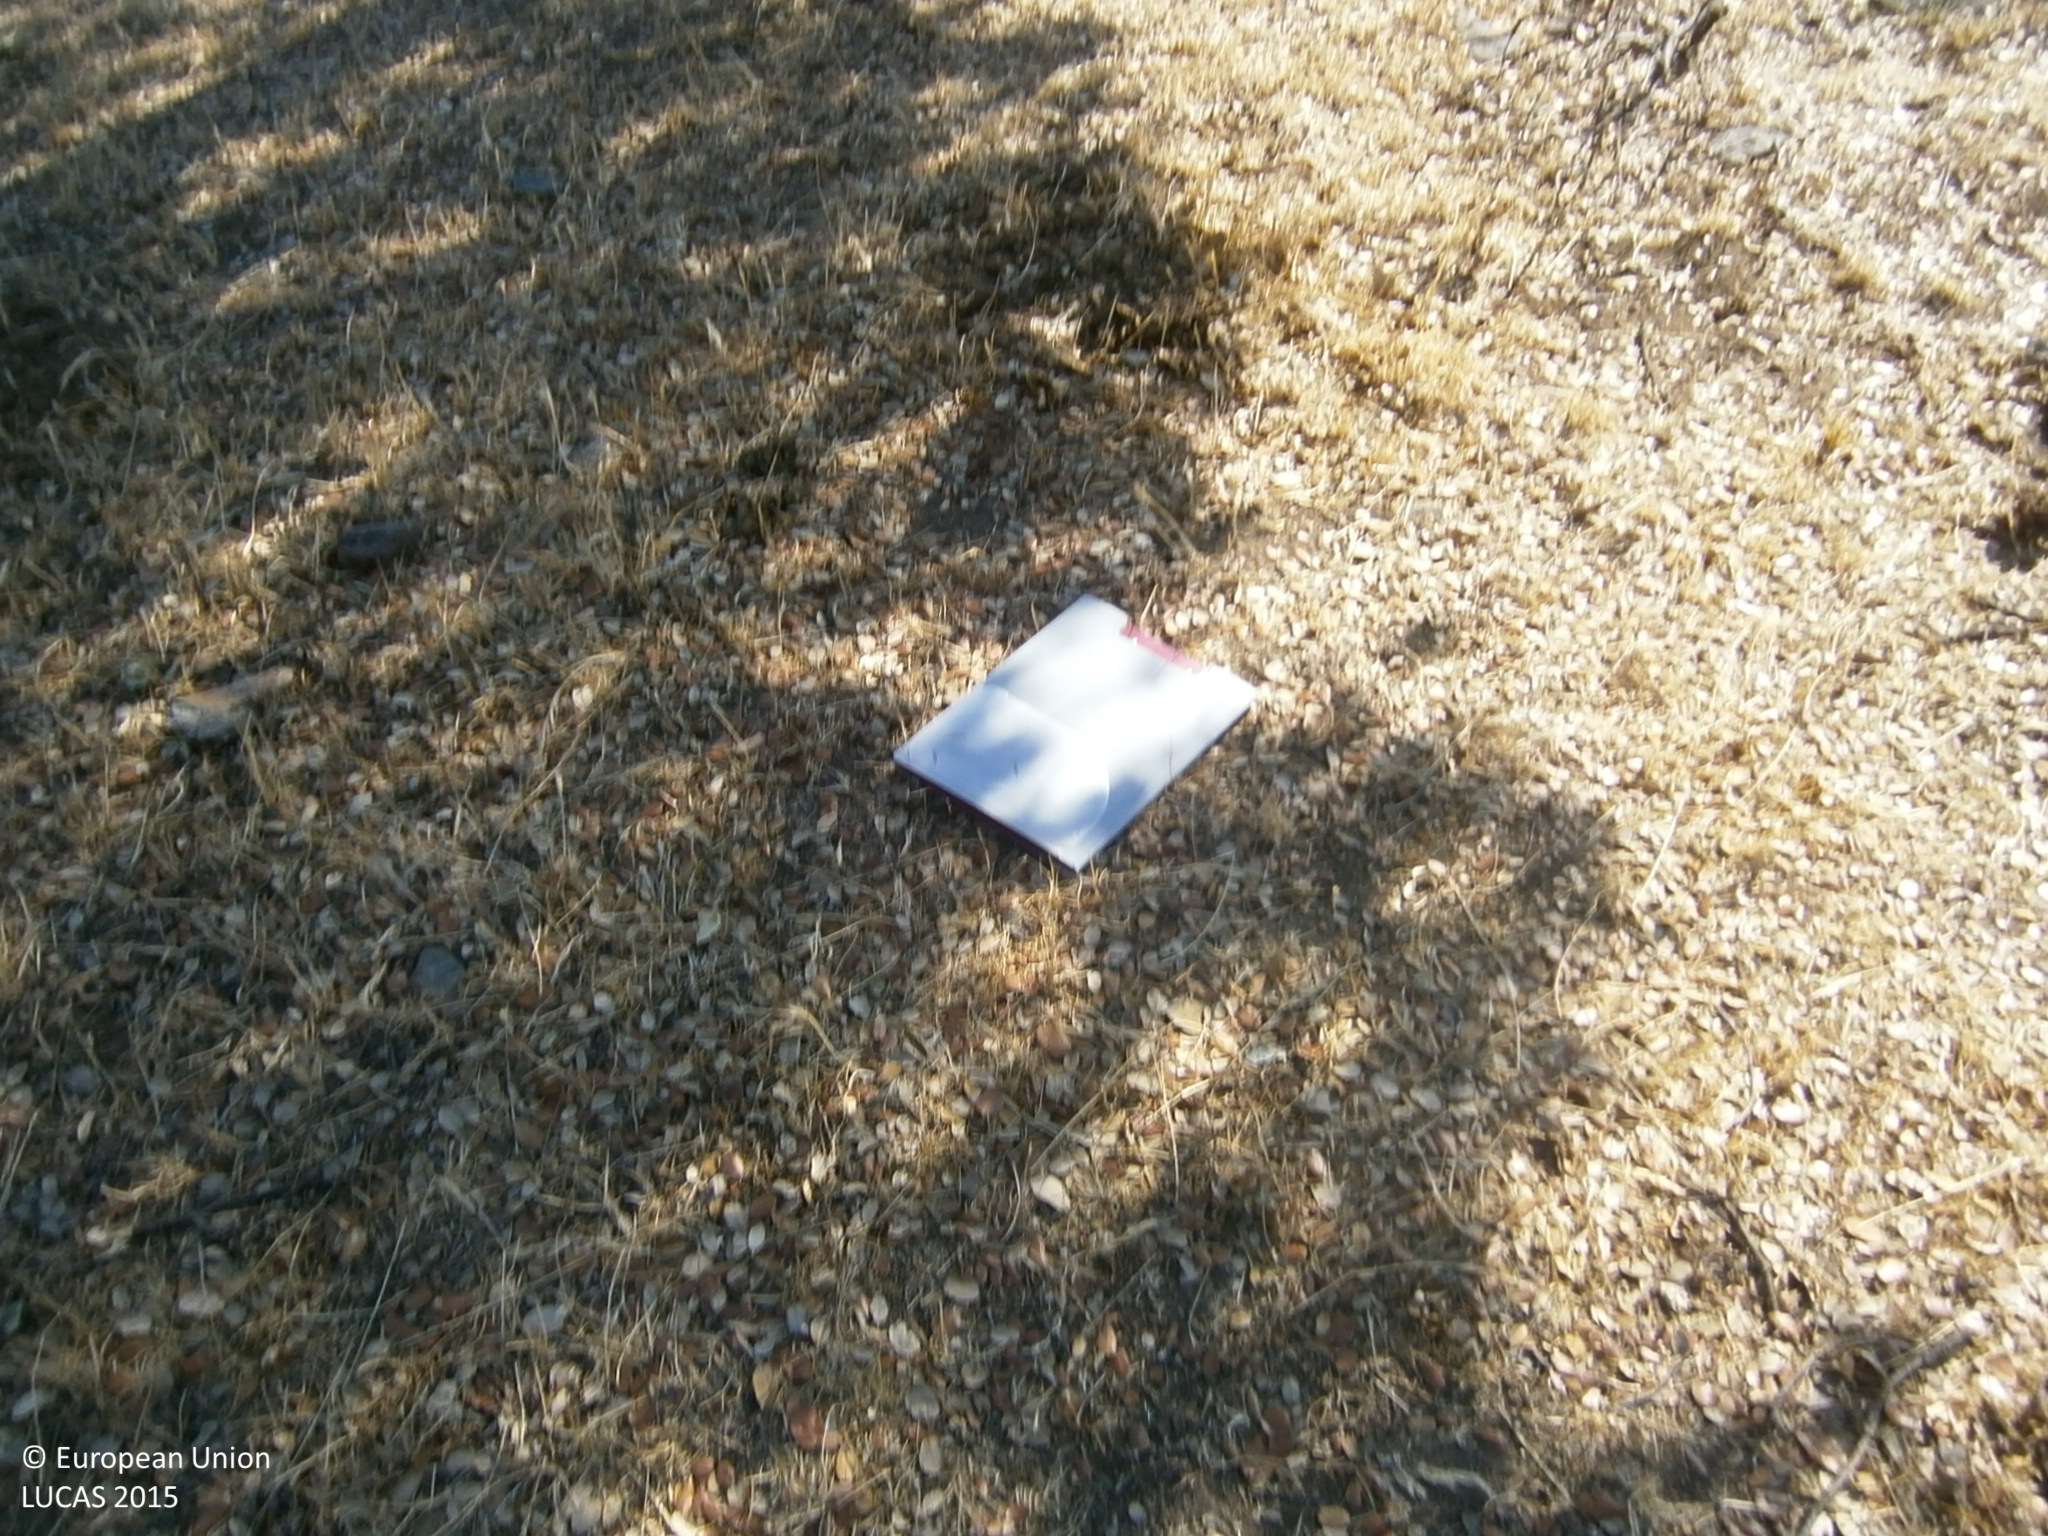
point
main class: Woodland
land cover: Broadleaved woodland
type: broadleaved evergreen forest
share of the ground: > 75 %
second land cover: Spontaneously vegetated surfaces
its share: > 75 %
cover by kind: broadleaved forest trees 90 %, unconsolidated bare surface 5 %
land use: Forestry
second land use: Agriculture (excluding fallow land and kitchen gardens)
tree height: > 5 m
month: June
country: ES
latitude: 38.5565
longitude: -6.7561
